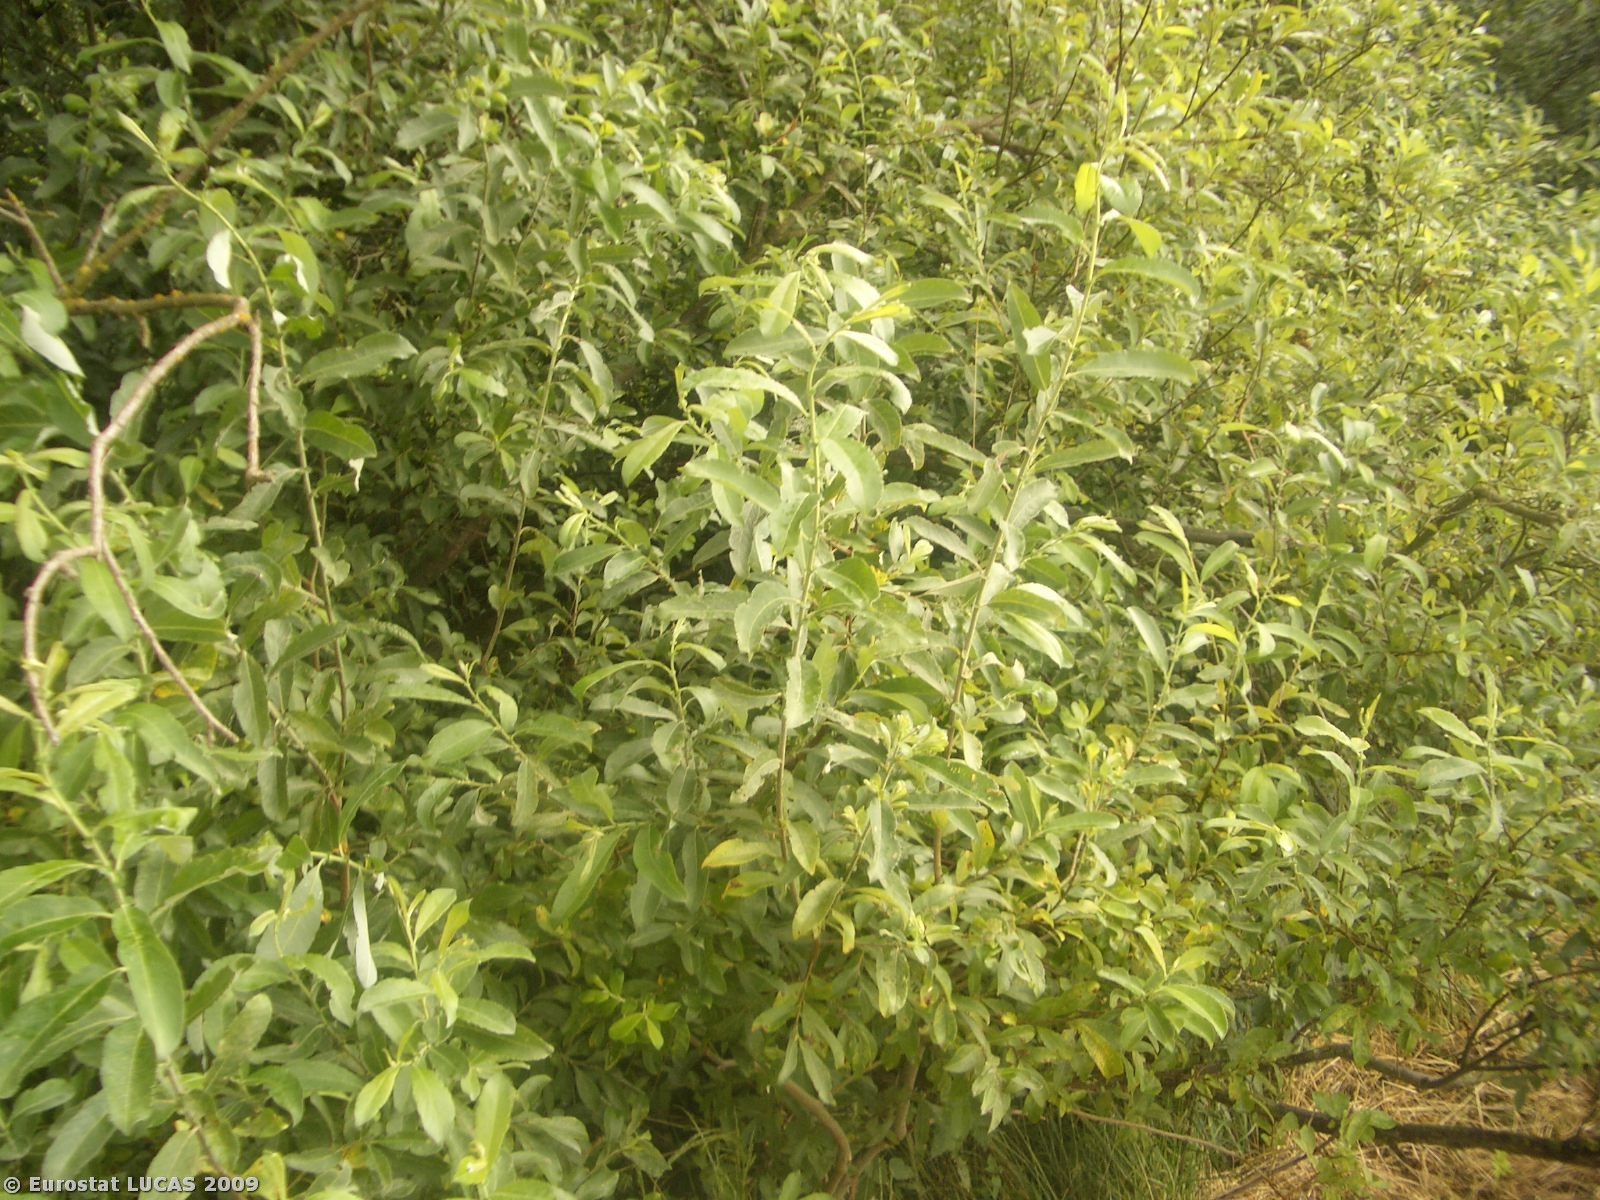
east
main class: Woodland
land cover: Broadleaved woodland
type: mesophytic deciduous forest
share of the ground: > 75 %
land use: Unused
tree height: > 5 m
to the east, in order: Broadleaved woodland; Grassland with sparse tree/shrub cover; Broadleaved woodland
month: July
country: PL
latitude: 51.3071
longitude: 22.3868
